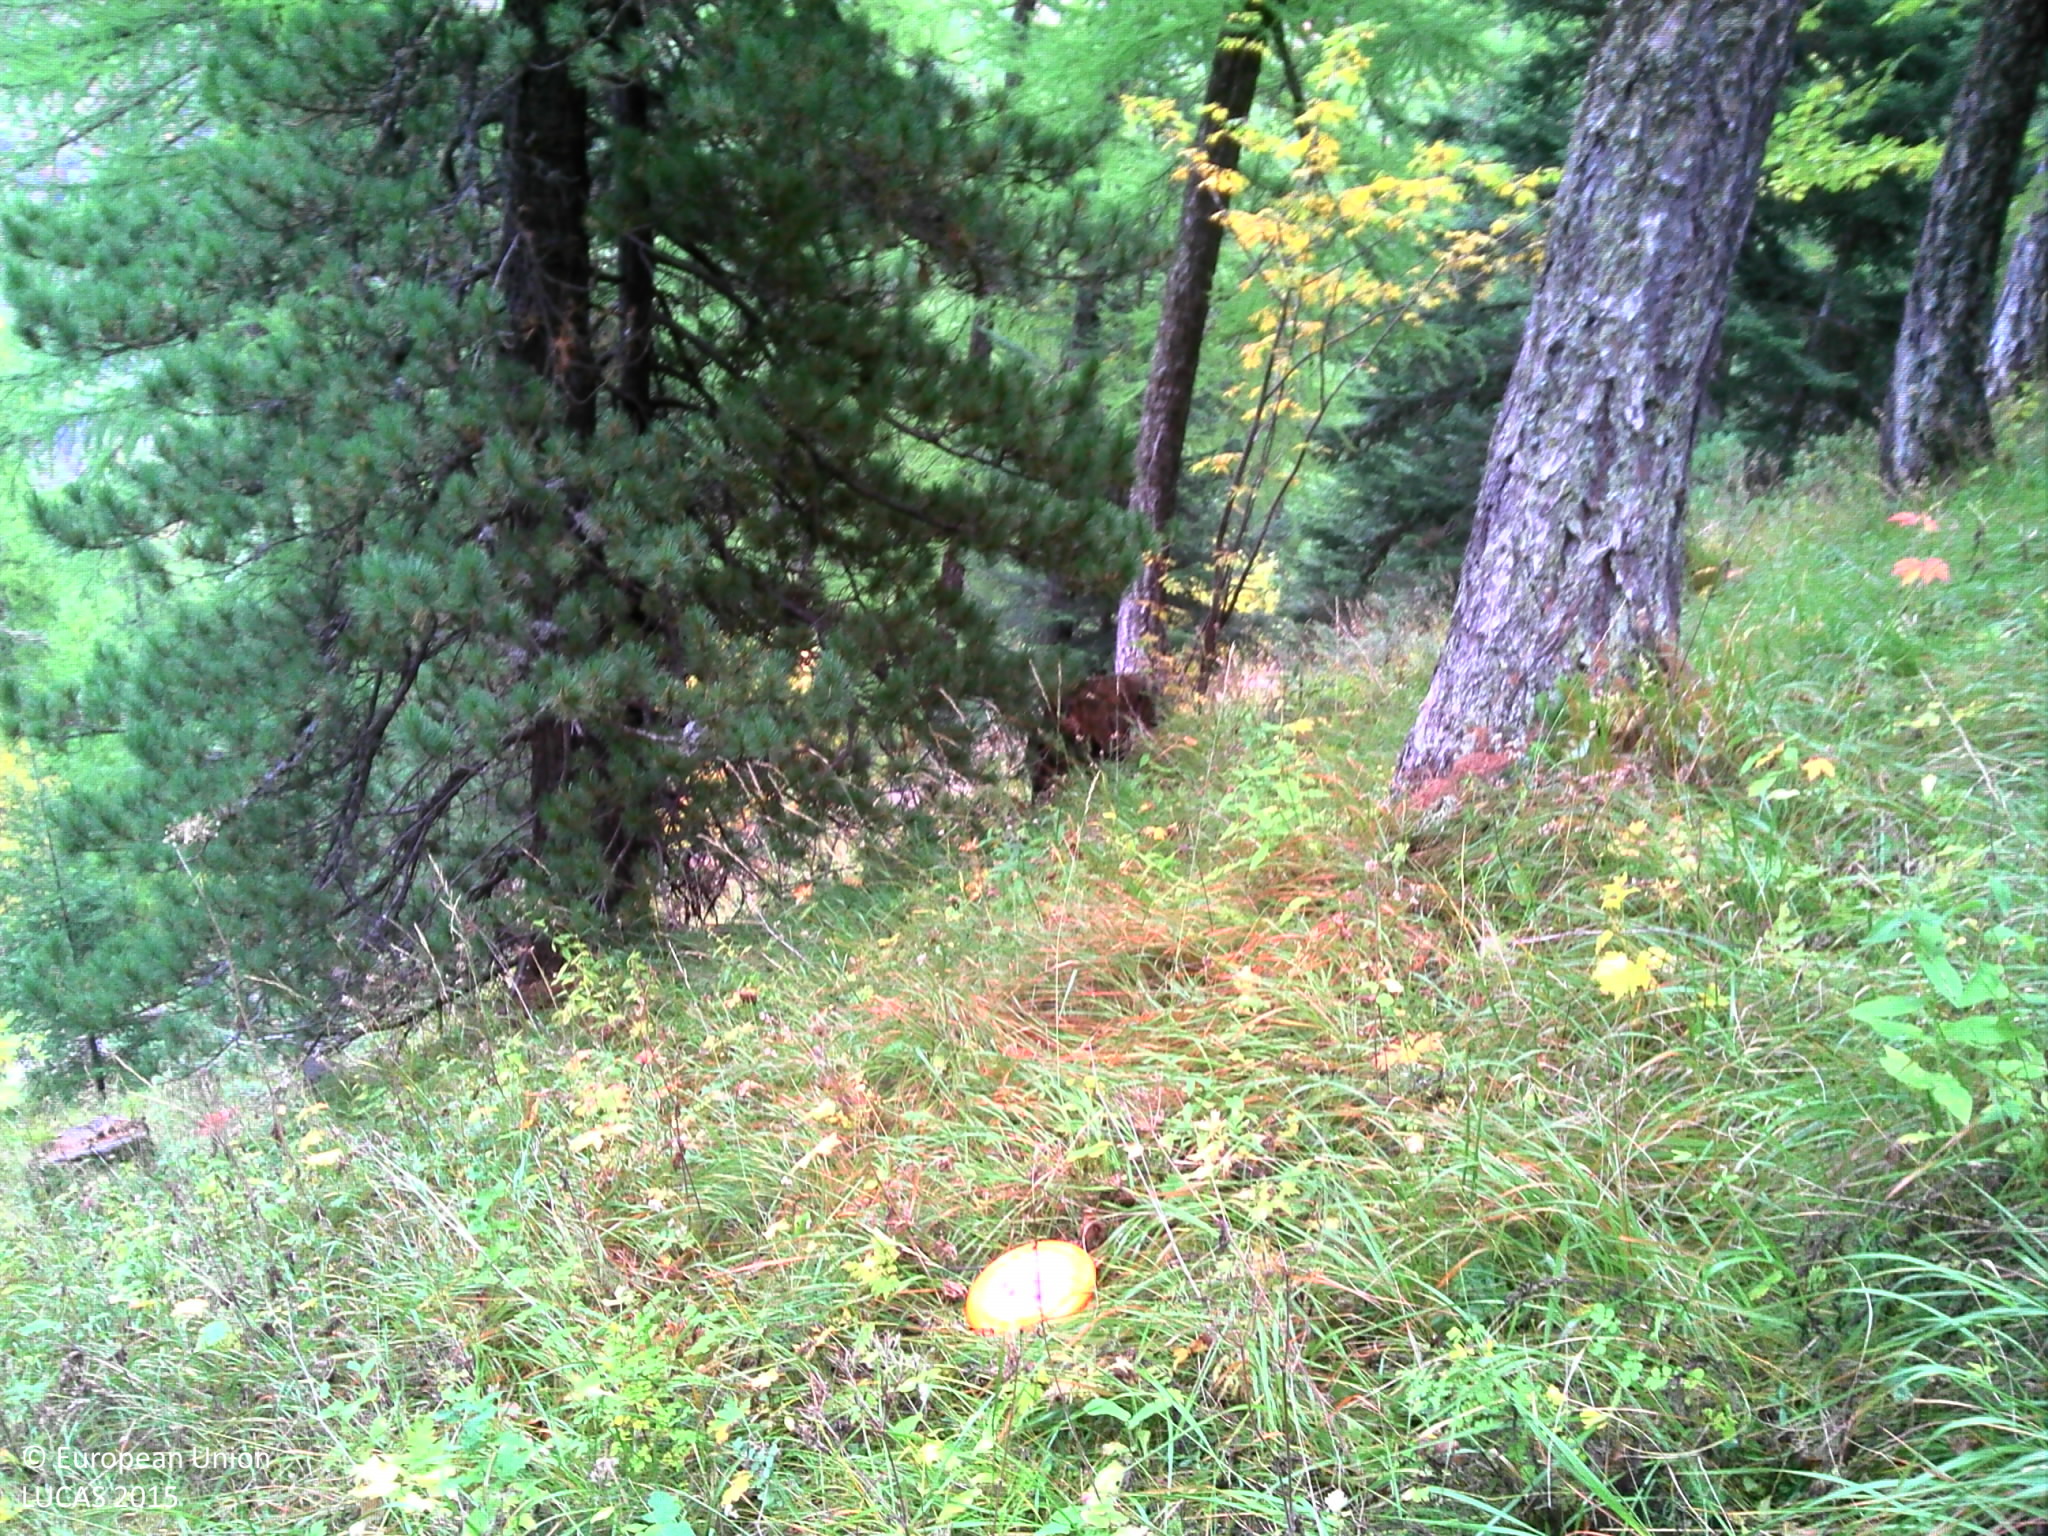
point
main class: Woodland
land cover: Other coniferous woodland
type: alpine coniferous forest
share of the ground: 50 - 75 %
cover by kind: coniferous forest trees 50 %, herbaceous plants 35 %, broadleaved forest trees 10 %, shrubs 5 %
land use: Forestry
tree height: > 5 m
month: September
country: FR
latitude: 44.5466
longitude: 6.5700
